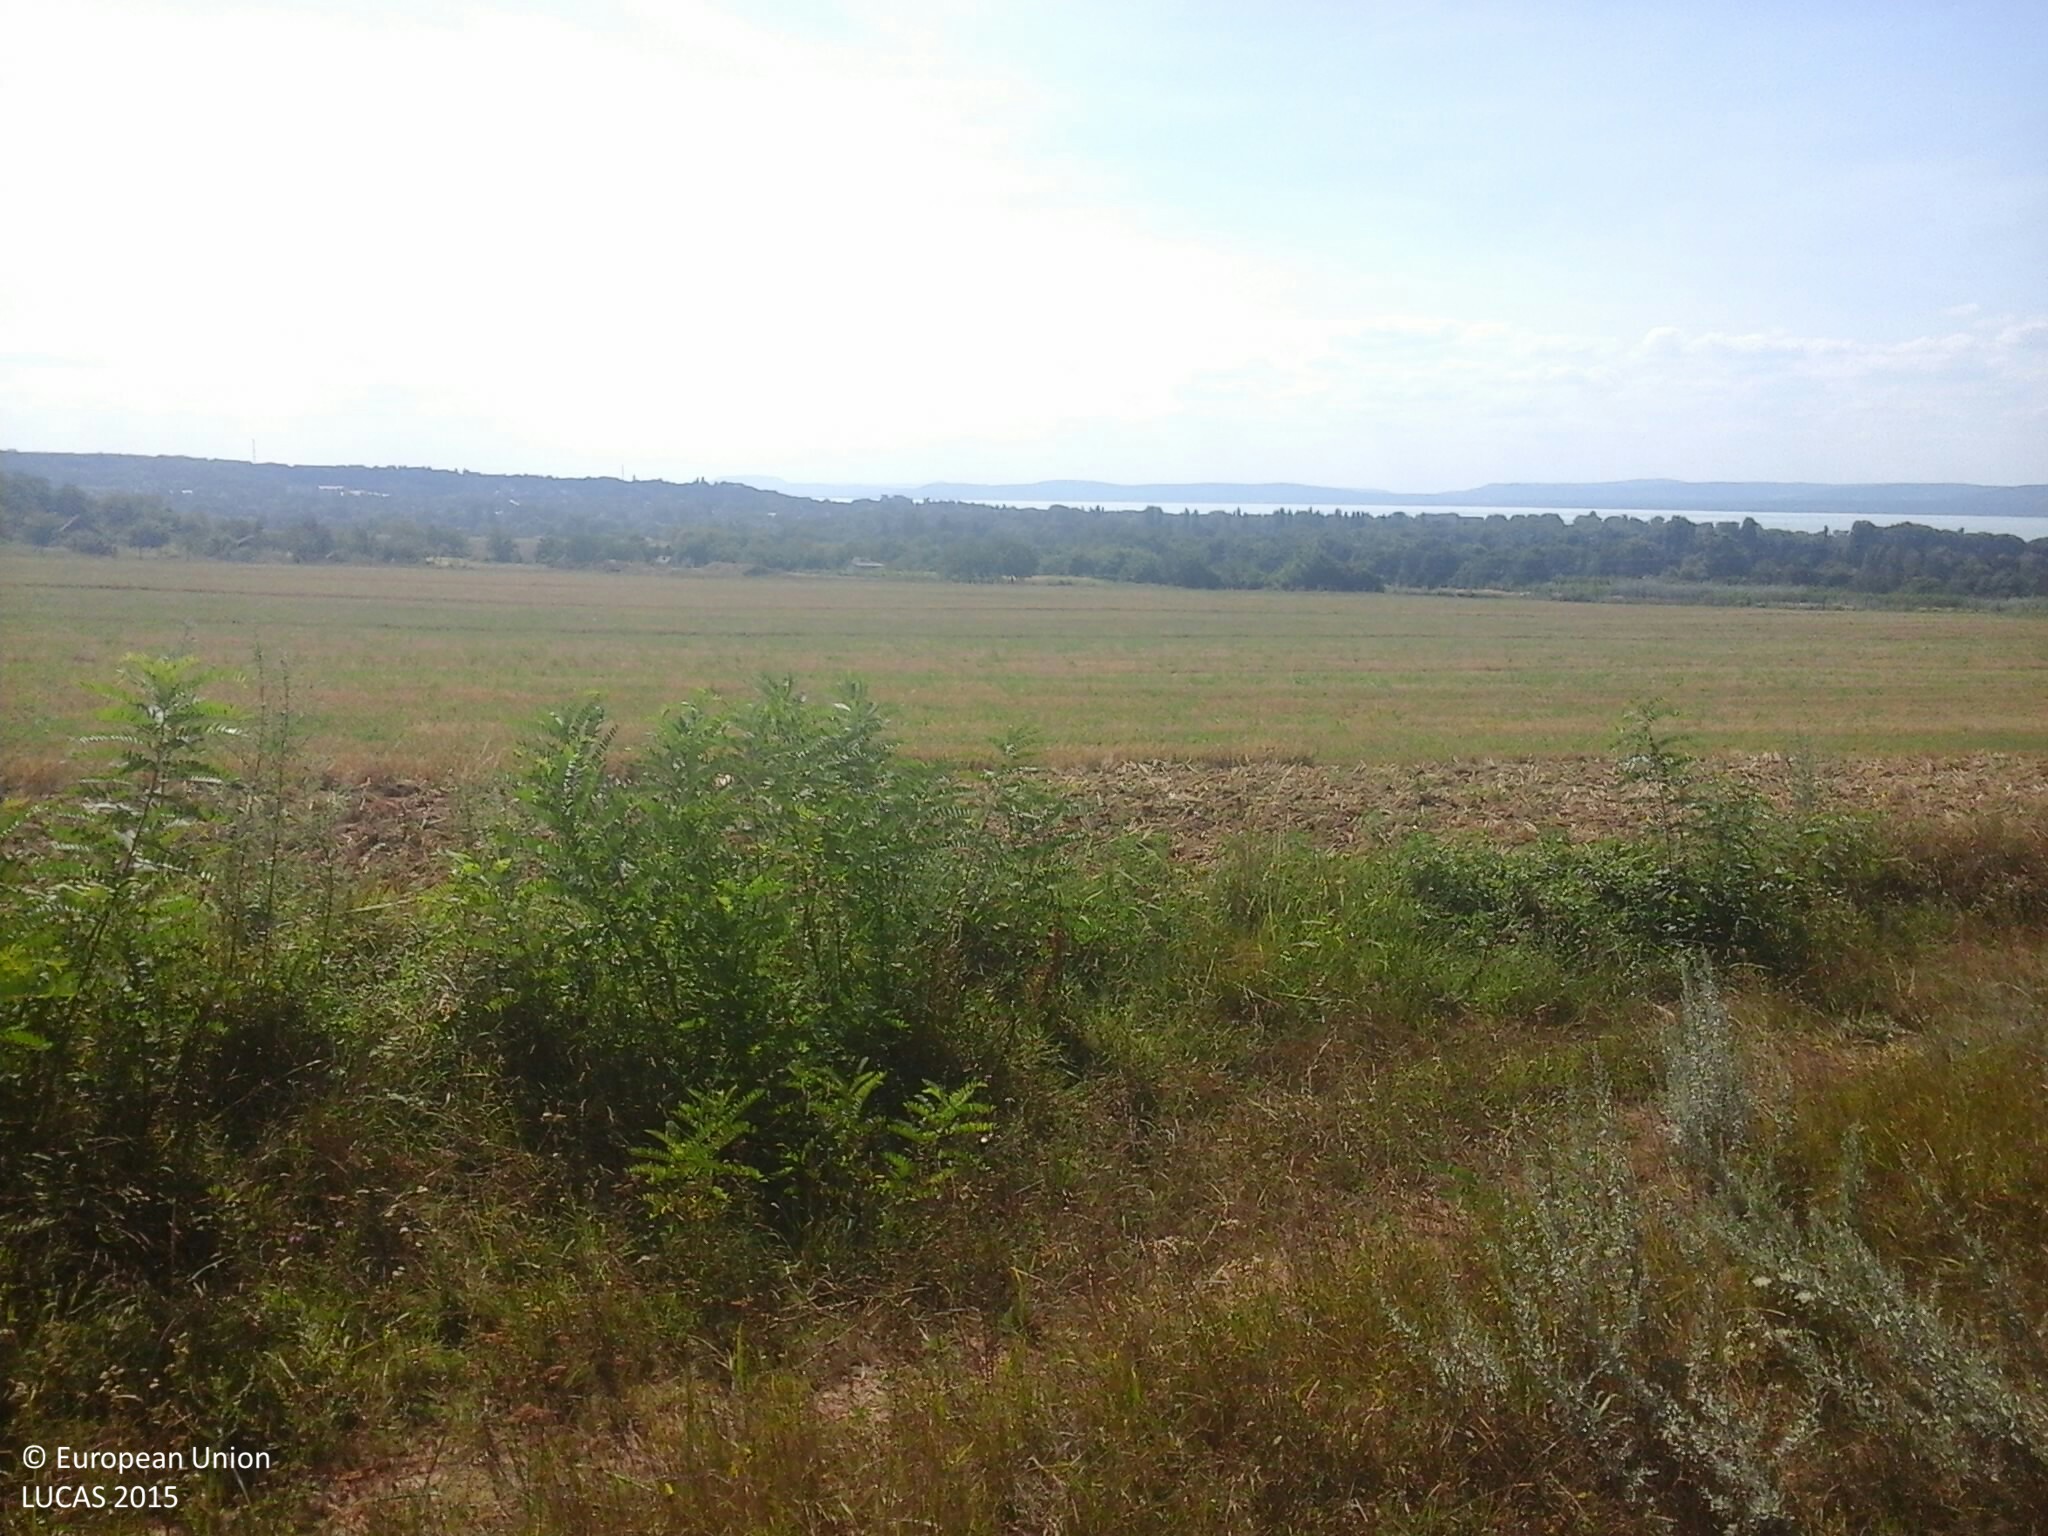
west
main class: Woodland
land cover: Broadleaved woodland
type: mesophytic deciduous forest
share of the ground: > 75 %
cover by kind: broadleaved forest trees 80 %, herbaceous plants 20 %
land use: Forestry
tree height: < 5 m
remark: Nursery
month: August
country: HU
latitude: 46.8535
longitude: 17.9168
